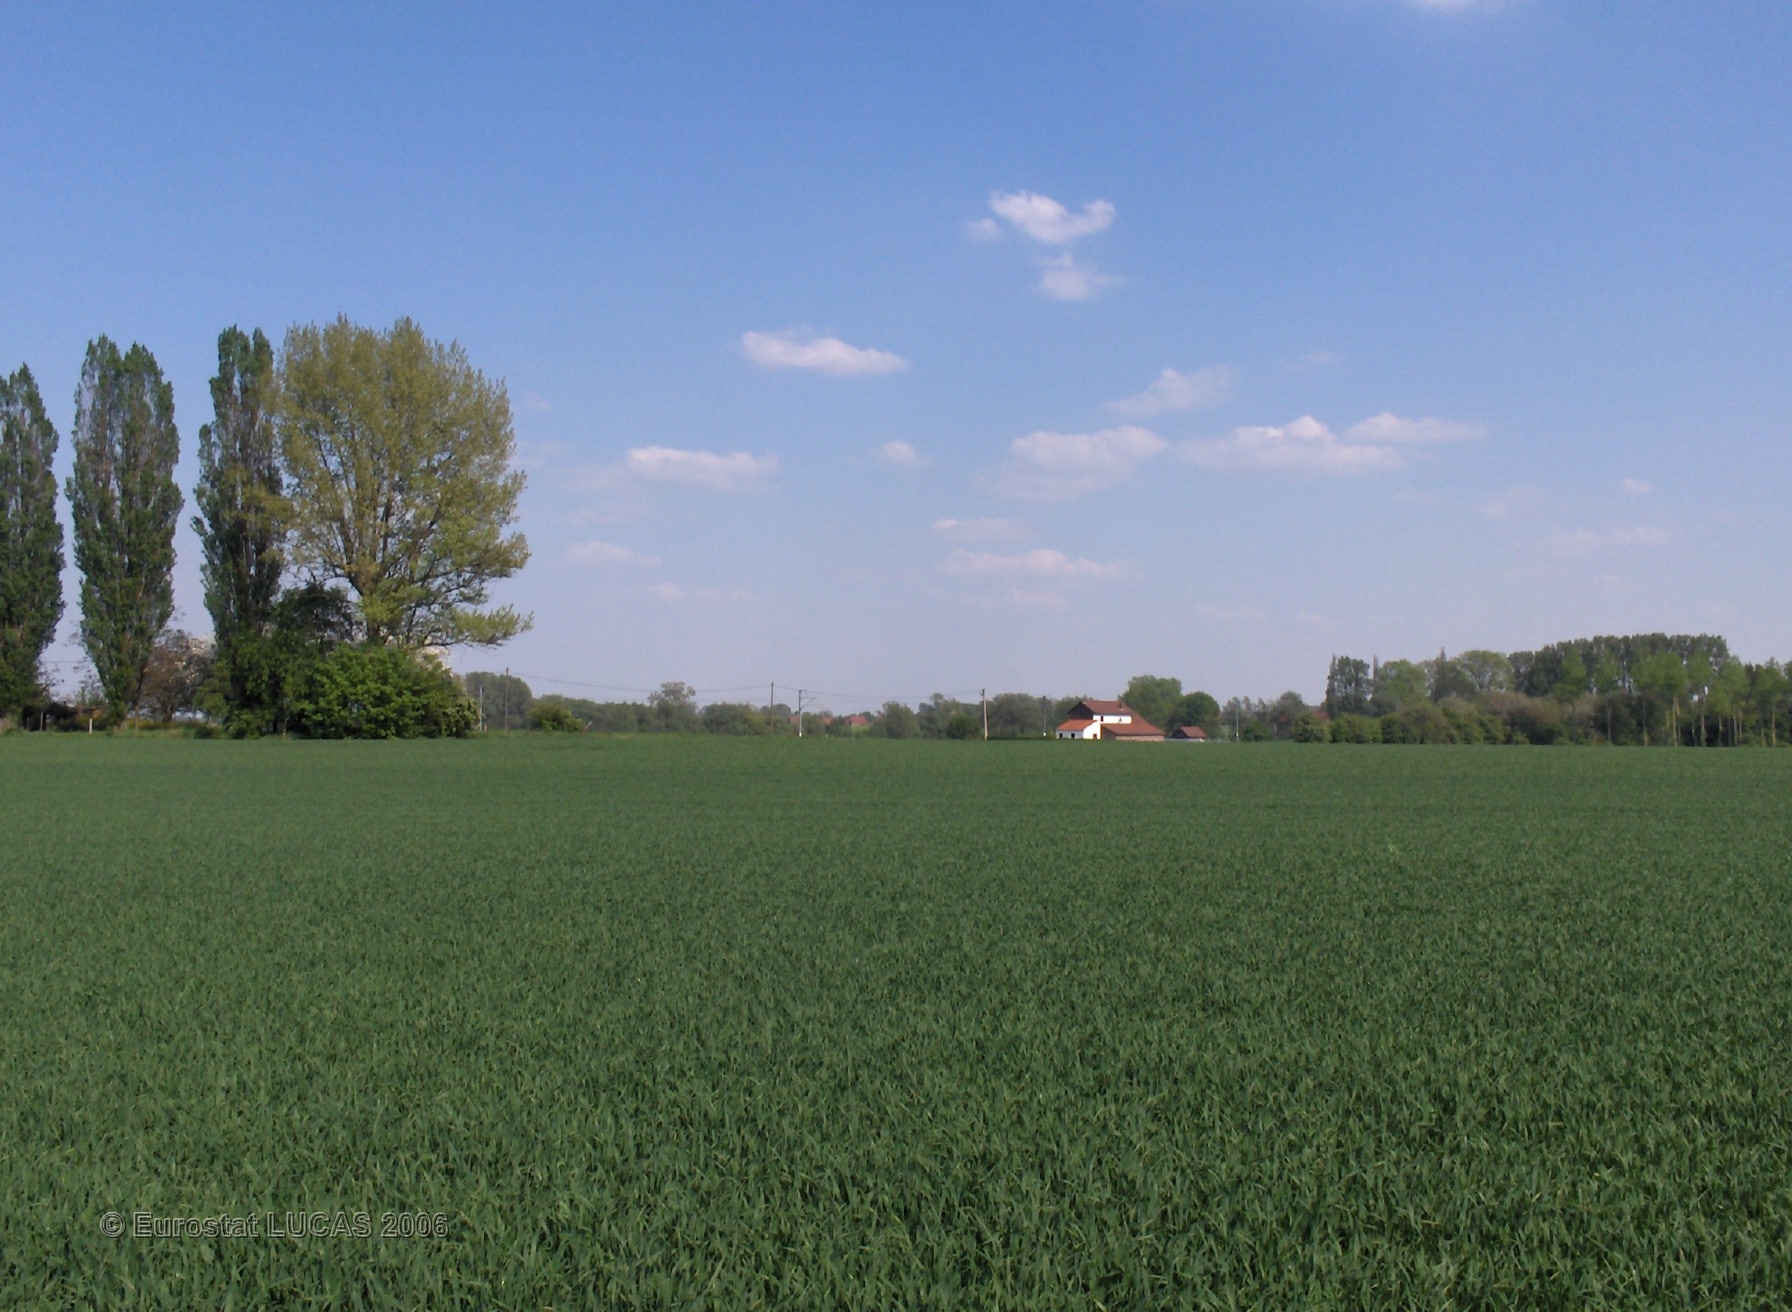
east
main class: Cropland
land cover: Common wheat
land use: Agriculture (excluding fallow land and kitchen gardens)
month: May
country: BE
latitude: 50.4682
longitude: 4.5436
